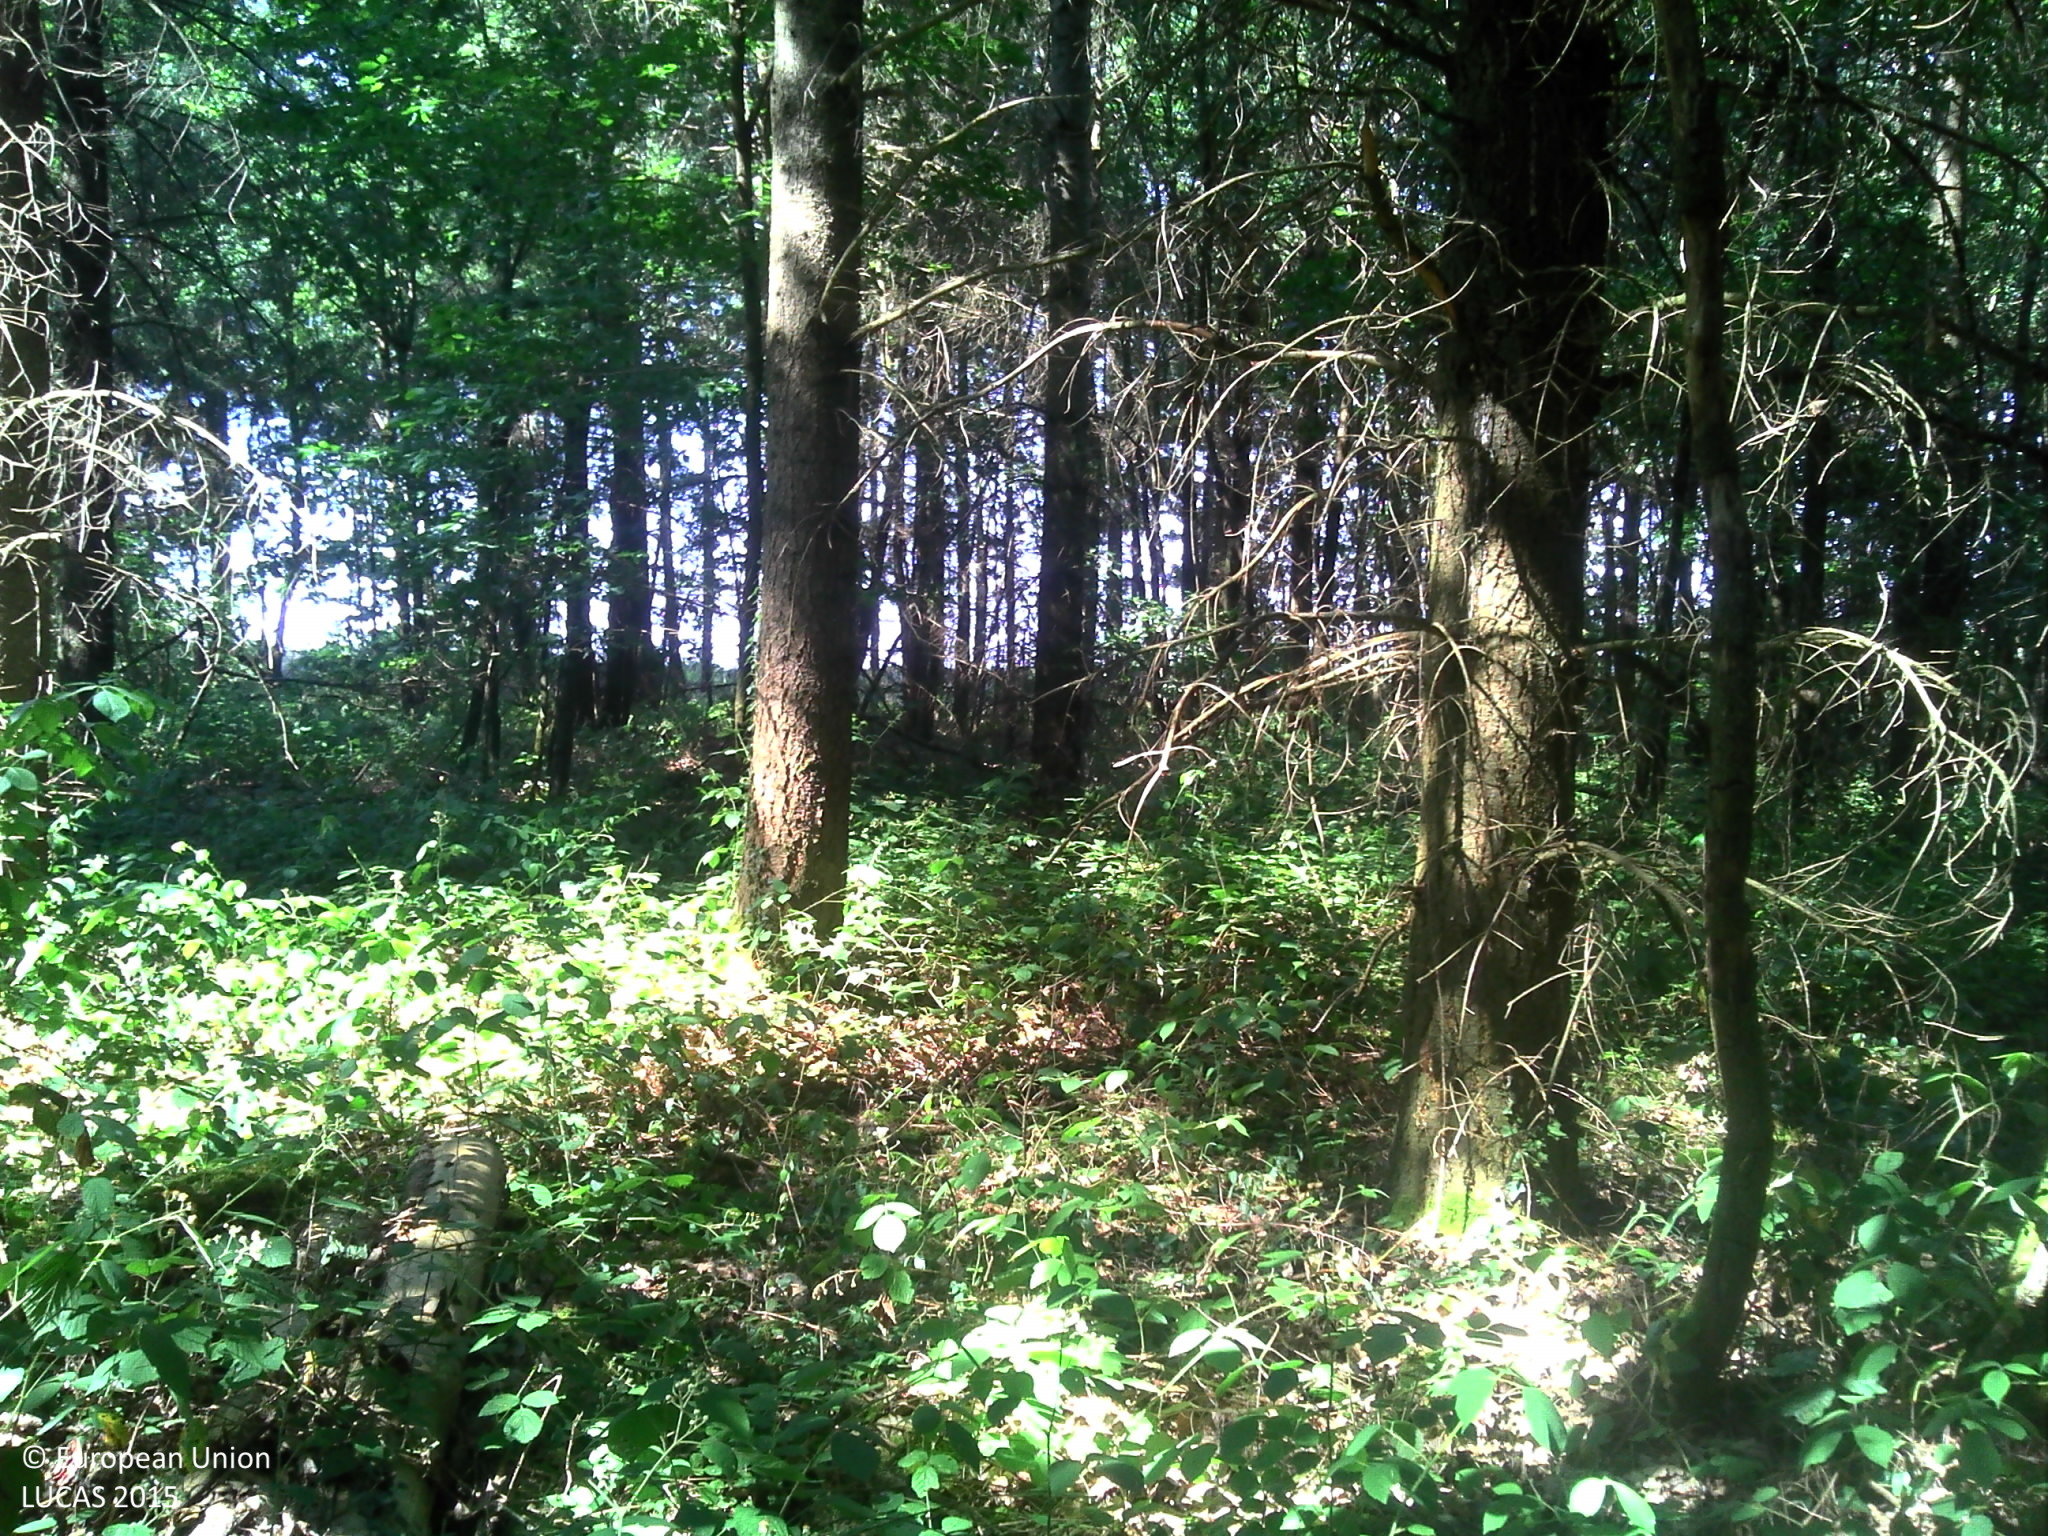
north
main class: Woodland
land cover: Other mixed woodland
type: exotic forest
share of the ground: > 75 %
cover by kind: broadleaved forest trees 75 %, coniferous forest trees 25 %
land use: Forestry
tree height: > 5 m
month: July
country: FR
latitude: 46.2538
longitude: 3.0842
